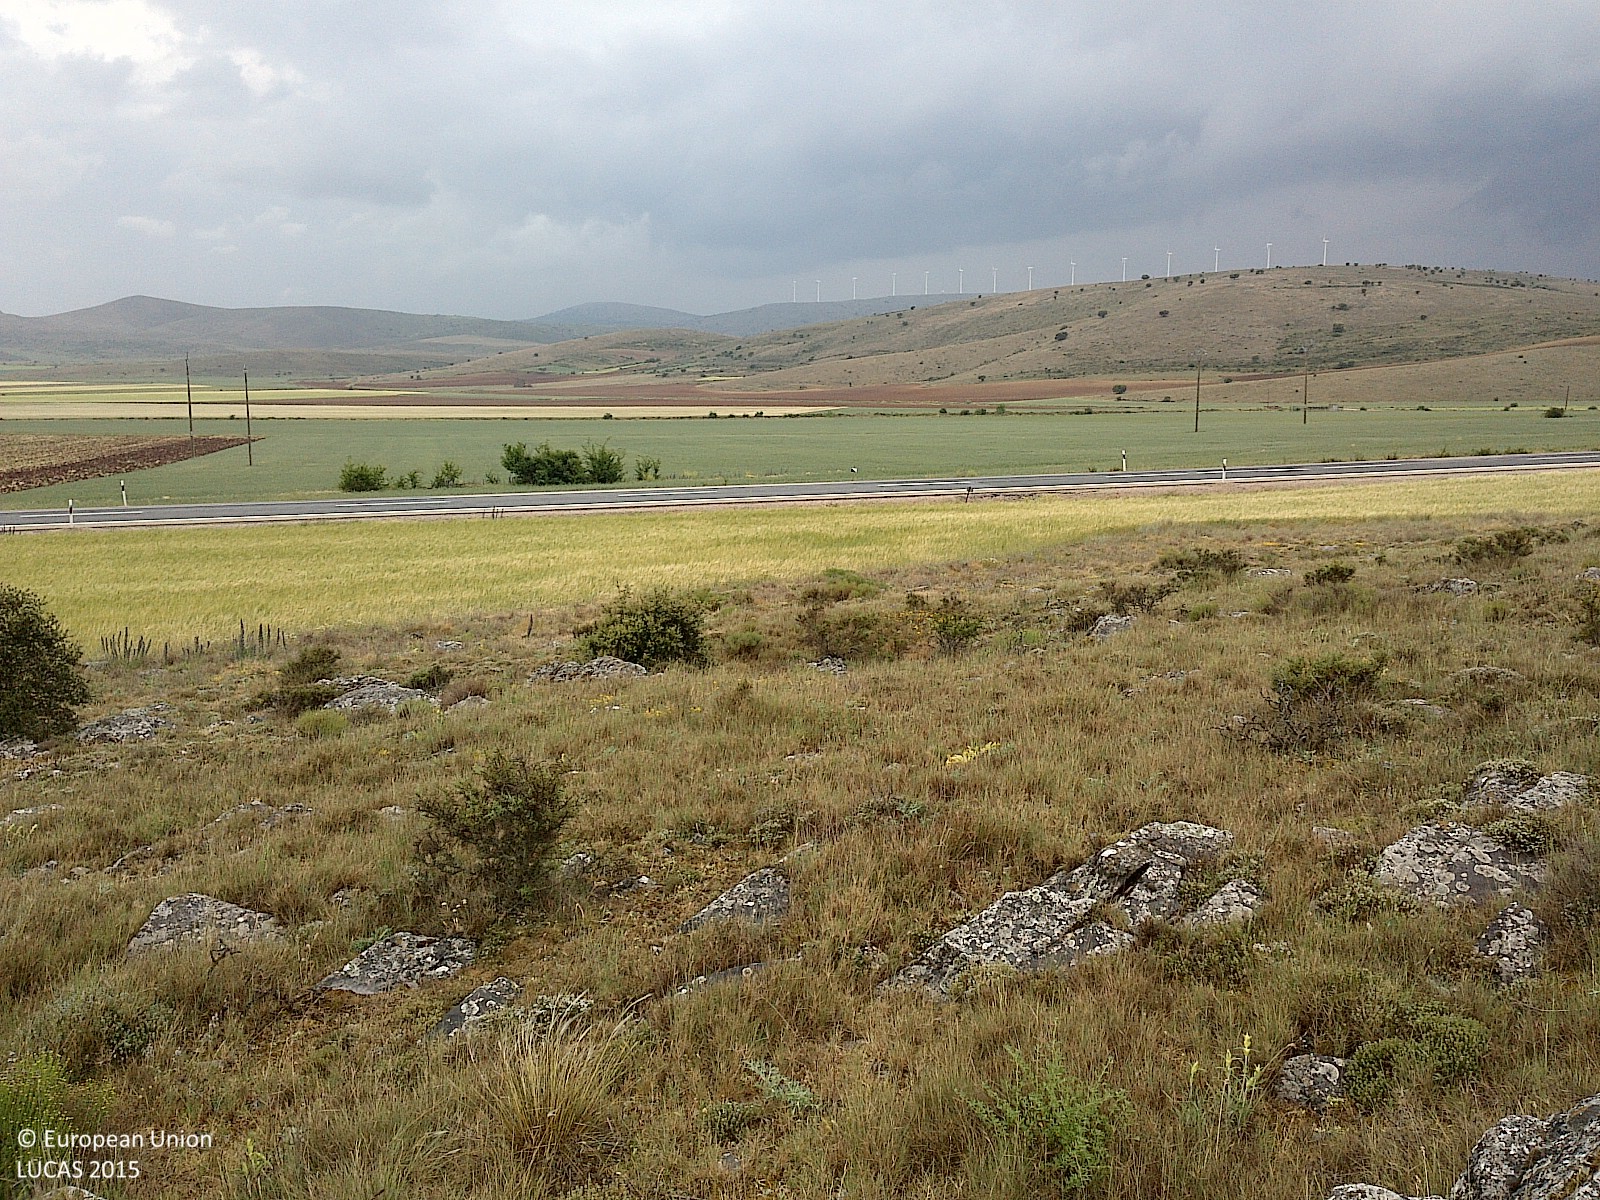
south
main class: Grassland
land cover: Grassland without tree/shrub cover
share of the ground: > 75 %
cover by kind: herbaceous plants 85 %, consolidated bare surface 10 %, shrubs 5 %
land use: Semi-natural and natural areas not in use
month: May
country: ES
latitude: 41.7858
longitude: -2.2001
